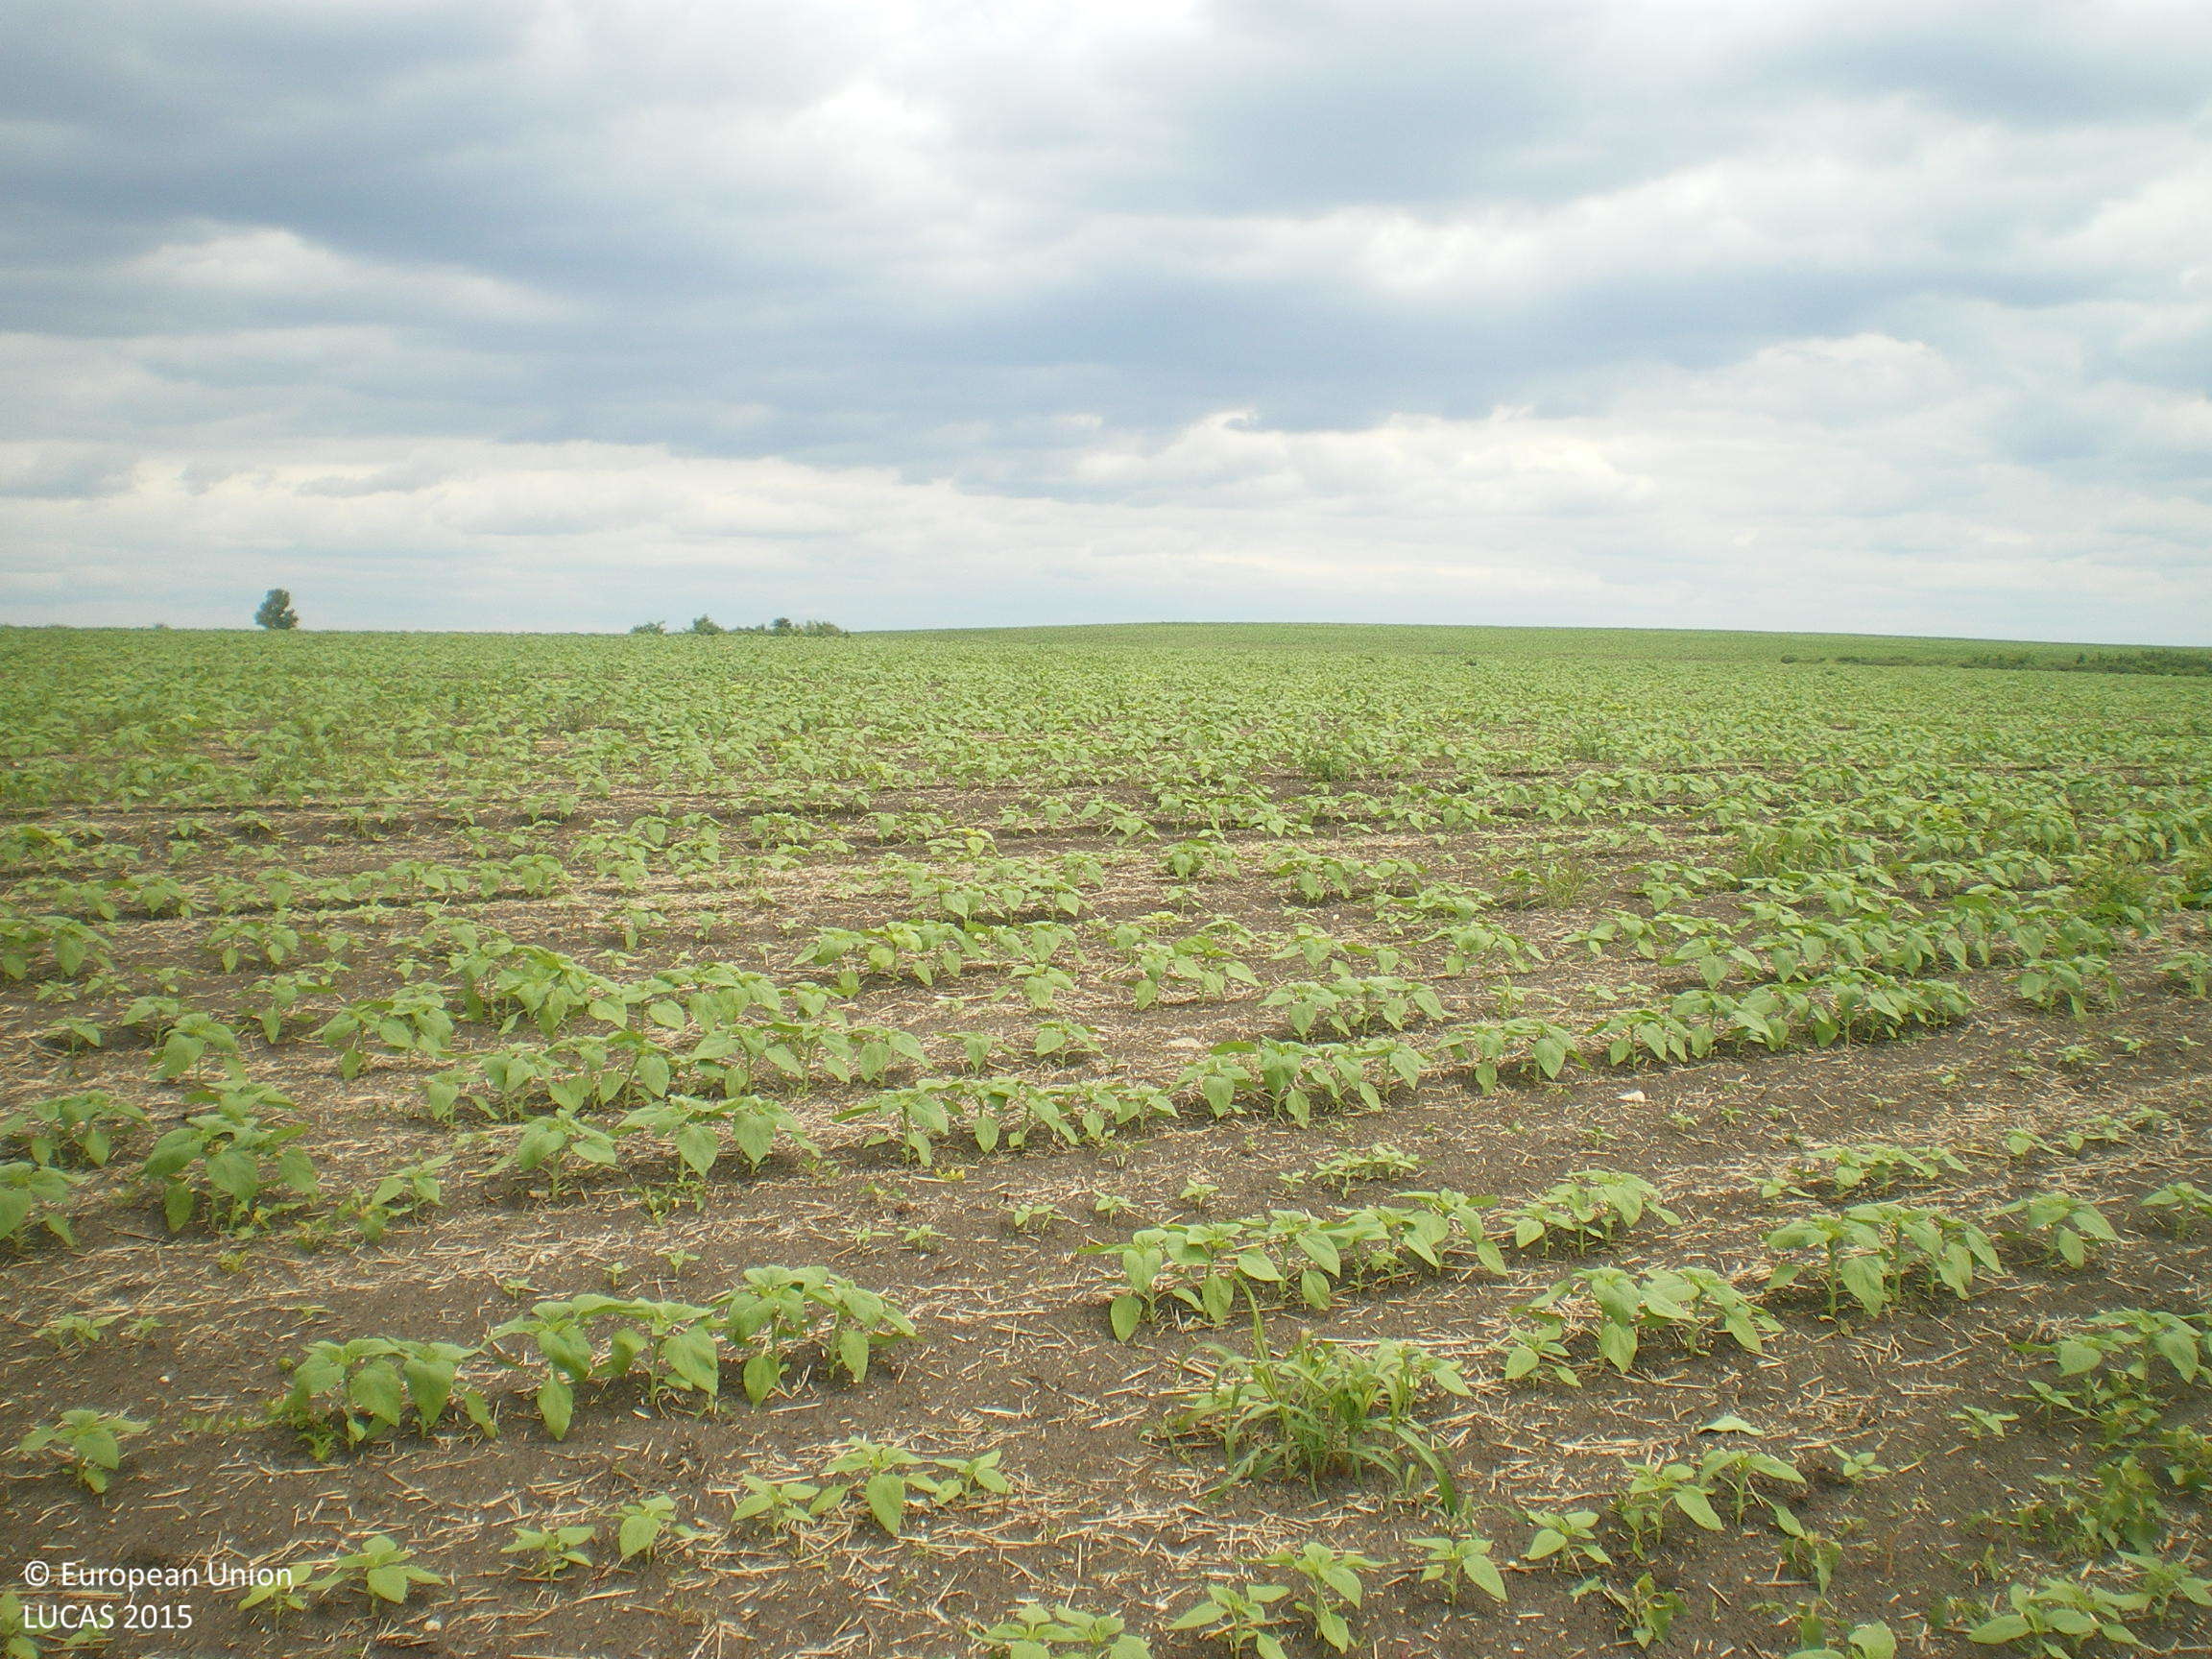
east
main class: Cropland
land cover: Sunflower
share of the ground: 10 - 25 %
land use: Agriculture (excluding fallow land and kitchen gardens)
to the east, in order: Sunflower
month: May
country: BG
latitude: 42.2323
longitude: 25.4421
